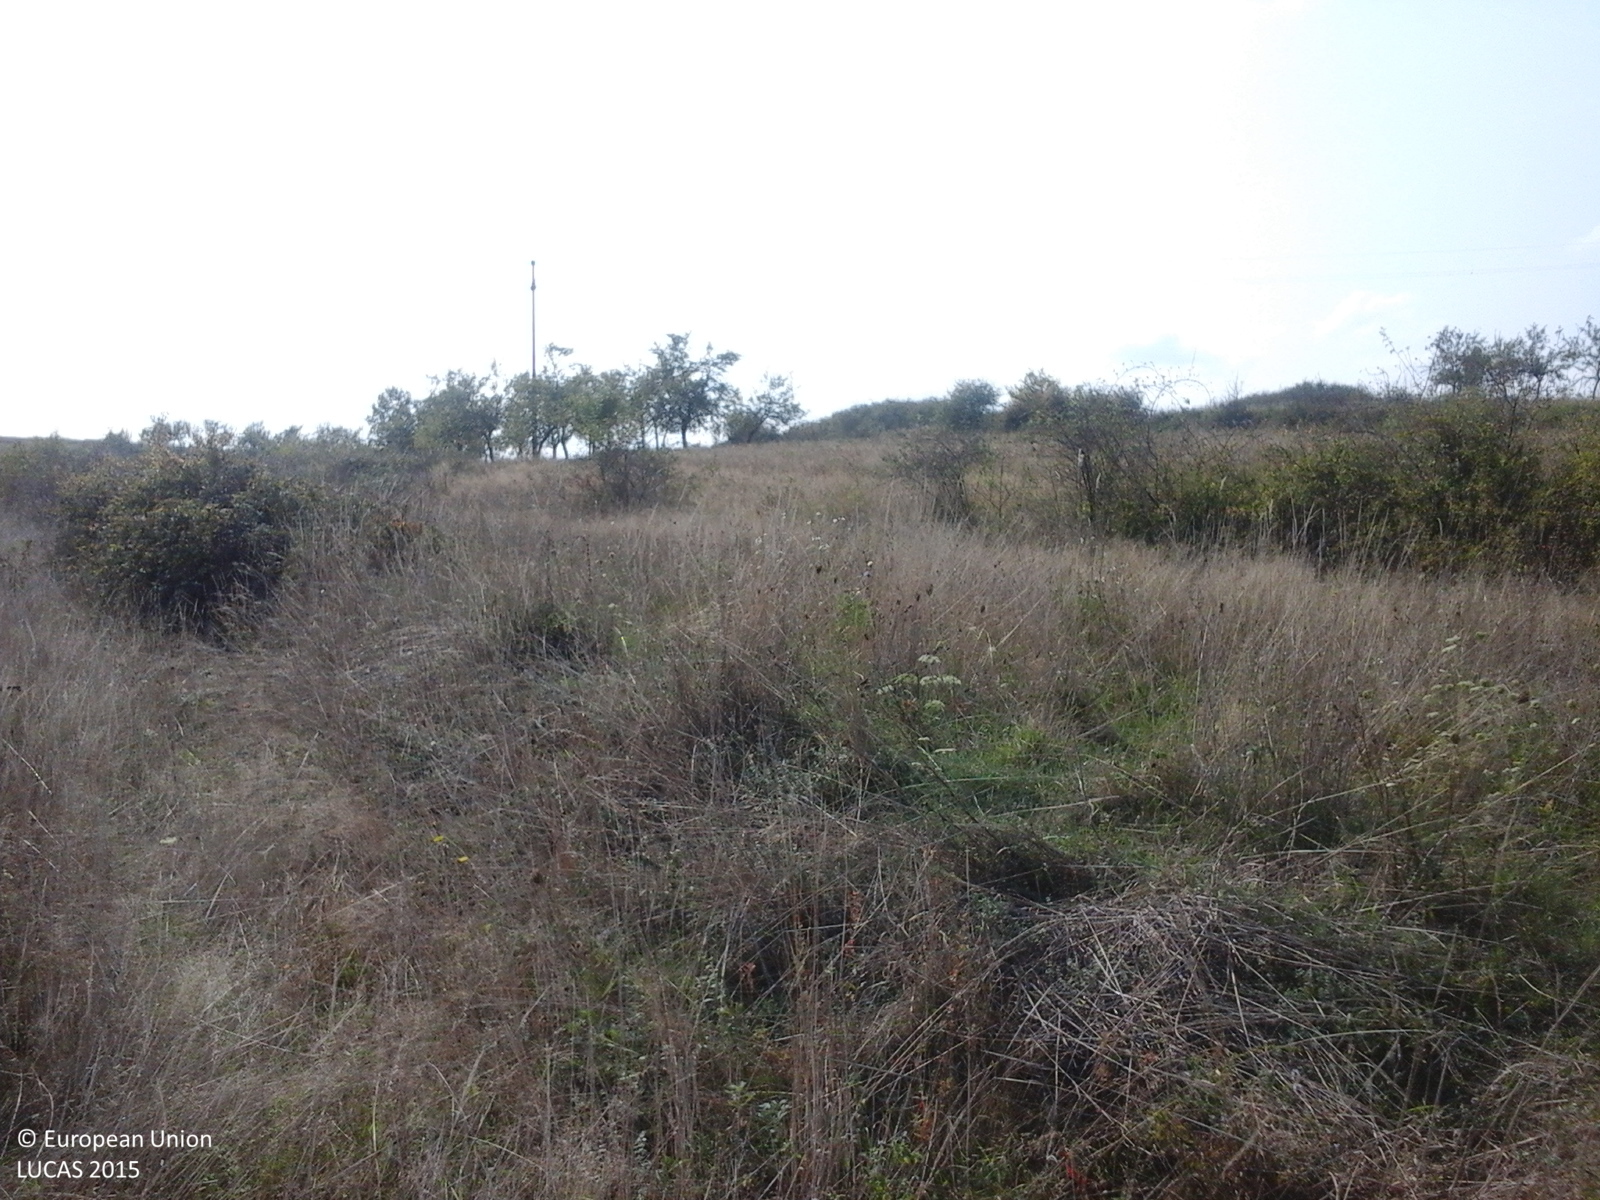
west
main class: Grassland
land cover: Grassland with sparse tree/shrub cover
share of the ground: > 75 %
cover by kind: herbaceous plants 85 %, shrubs 10 %, broadleaved forest trees 5 %
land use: Fallow land
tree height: < 5 m
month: September
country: RO
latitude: 45.8192
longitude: 22.3103
